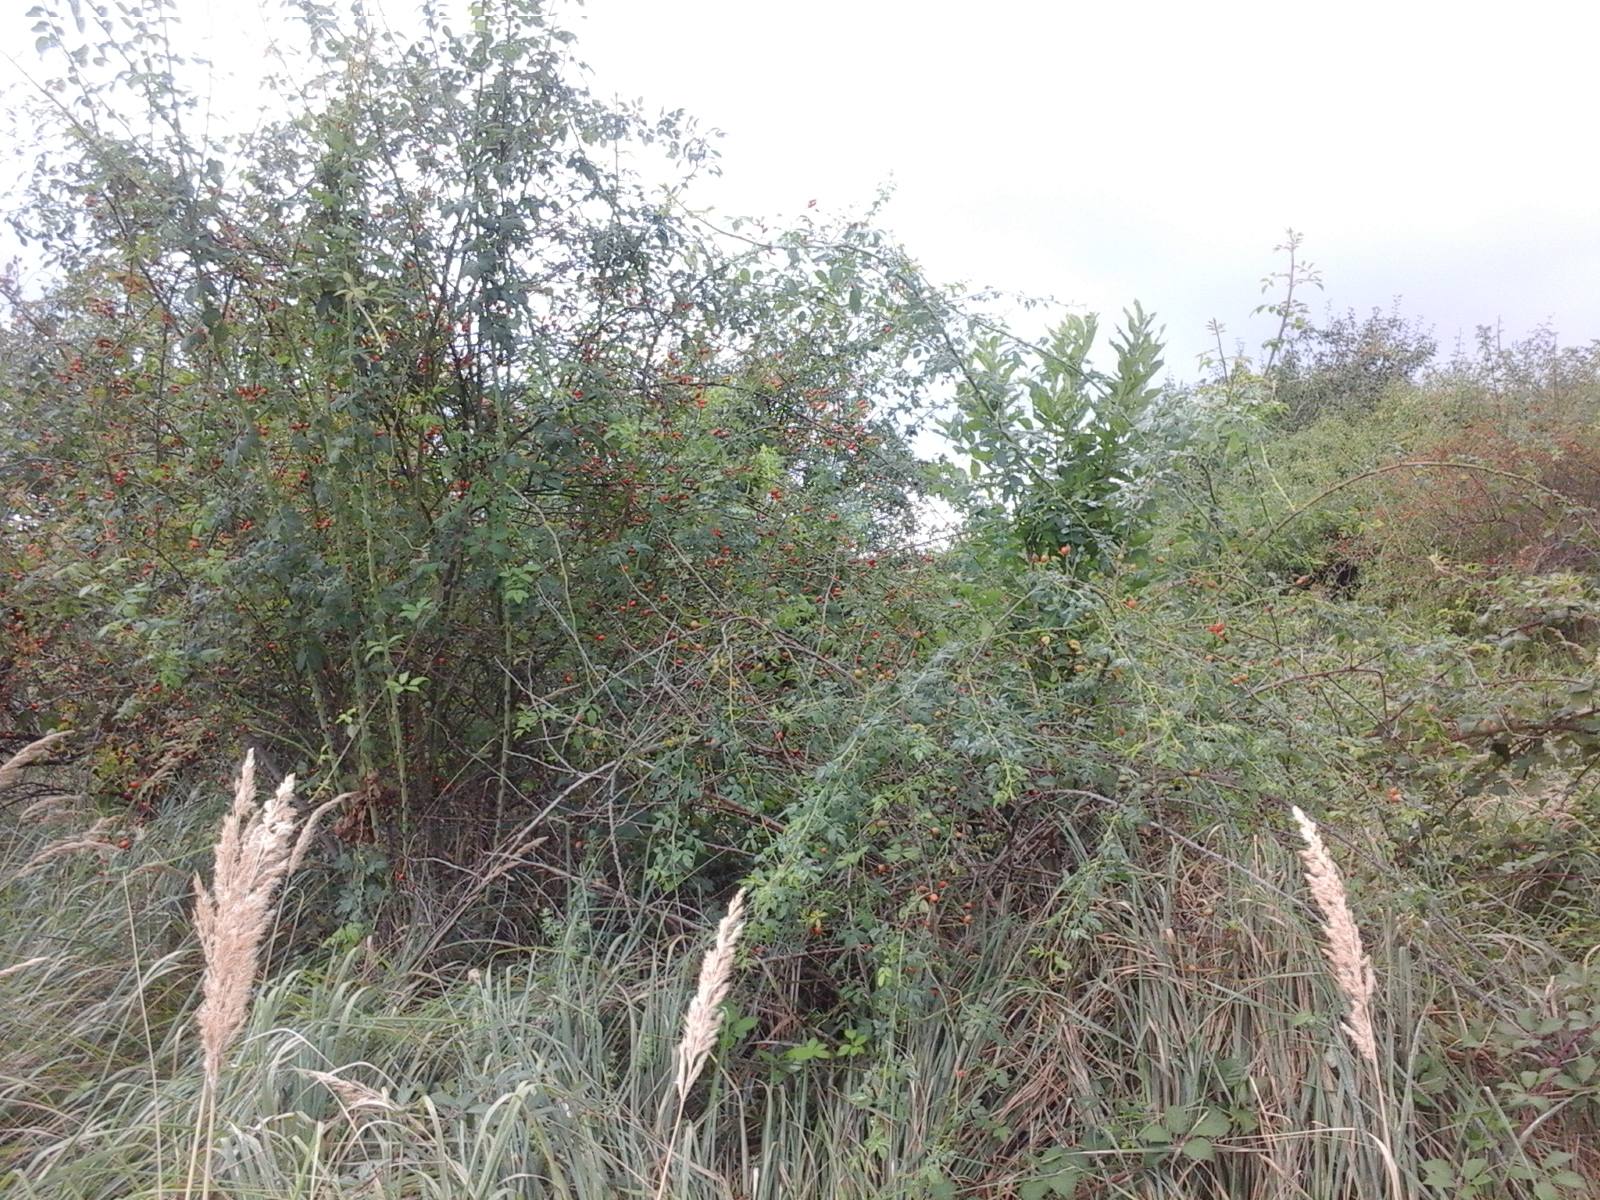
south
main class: Shrubland
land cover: Shrubland without tree cover
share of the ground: > 75 %
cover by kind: shrubs 100 %
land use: Semi-natural and natural areas not in use
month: September
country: RO
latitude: 46.9747
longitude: 22.0756
